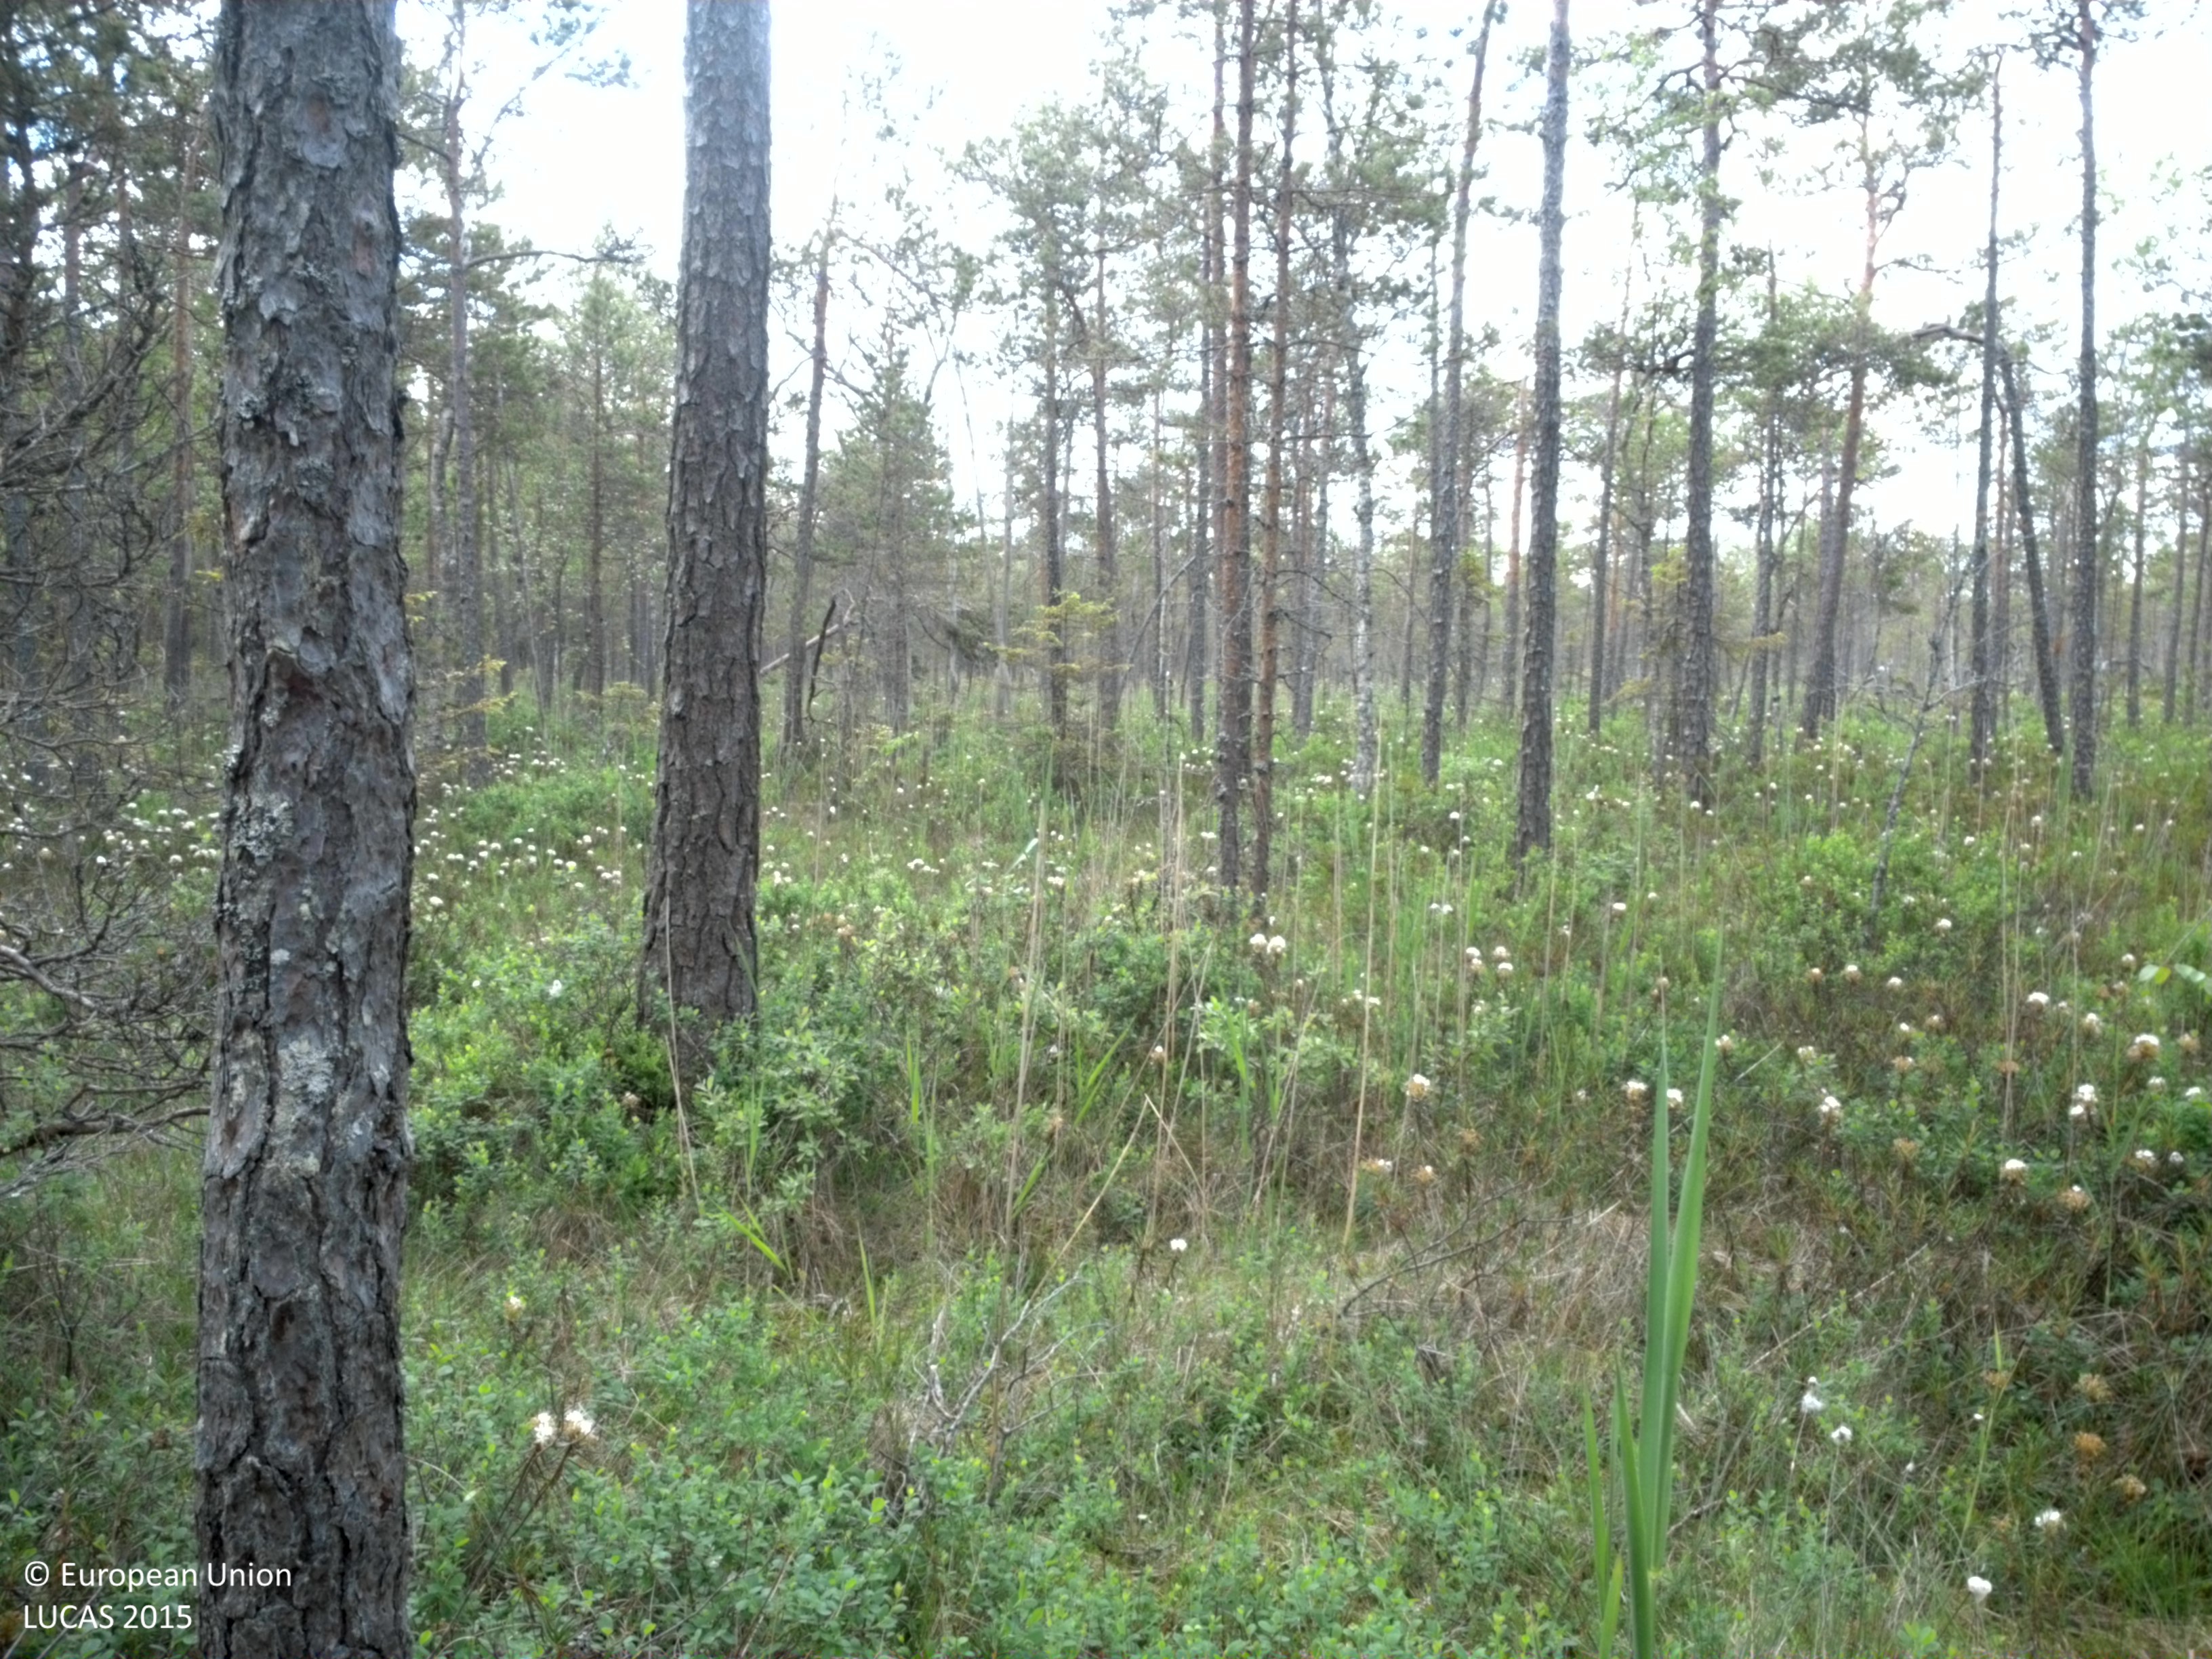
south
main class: Woodland
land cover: Pine dominated coniferous woodland
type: boreal forest
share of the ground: 25 - 50 %
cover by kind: coniferous forest trees 45 %, herbaceous plants 25 %, lichens and mosses 25 %, broadleaved forest trees 5 %
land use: Forestry
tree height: > 5 m
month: June
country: SE
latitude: 59.9458
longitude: 17.1348
